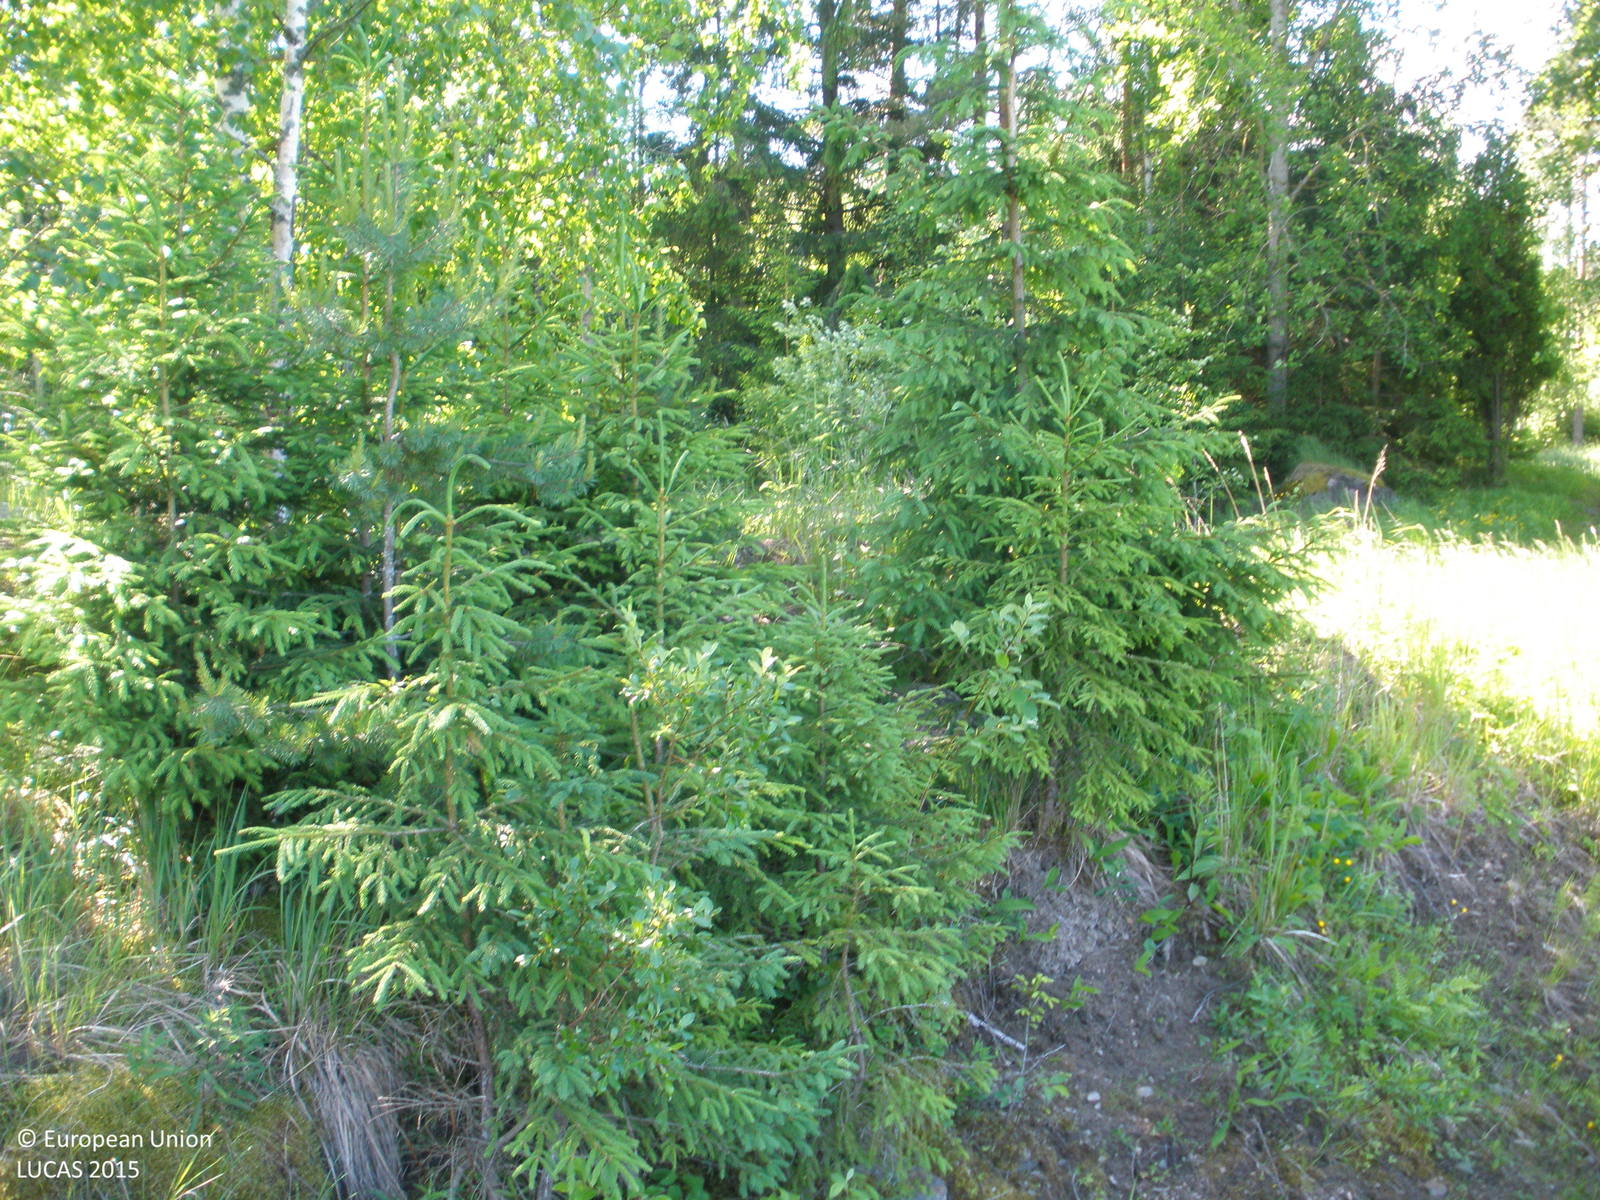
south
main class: Cropland
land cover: Common wheat
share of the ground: 50 - 75 %
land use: Agriculture (excluding fallow land and kitchen gardens)
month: June
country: FI
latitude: 61.1103
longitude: 24.1785
